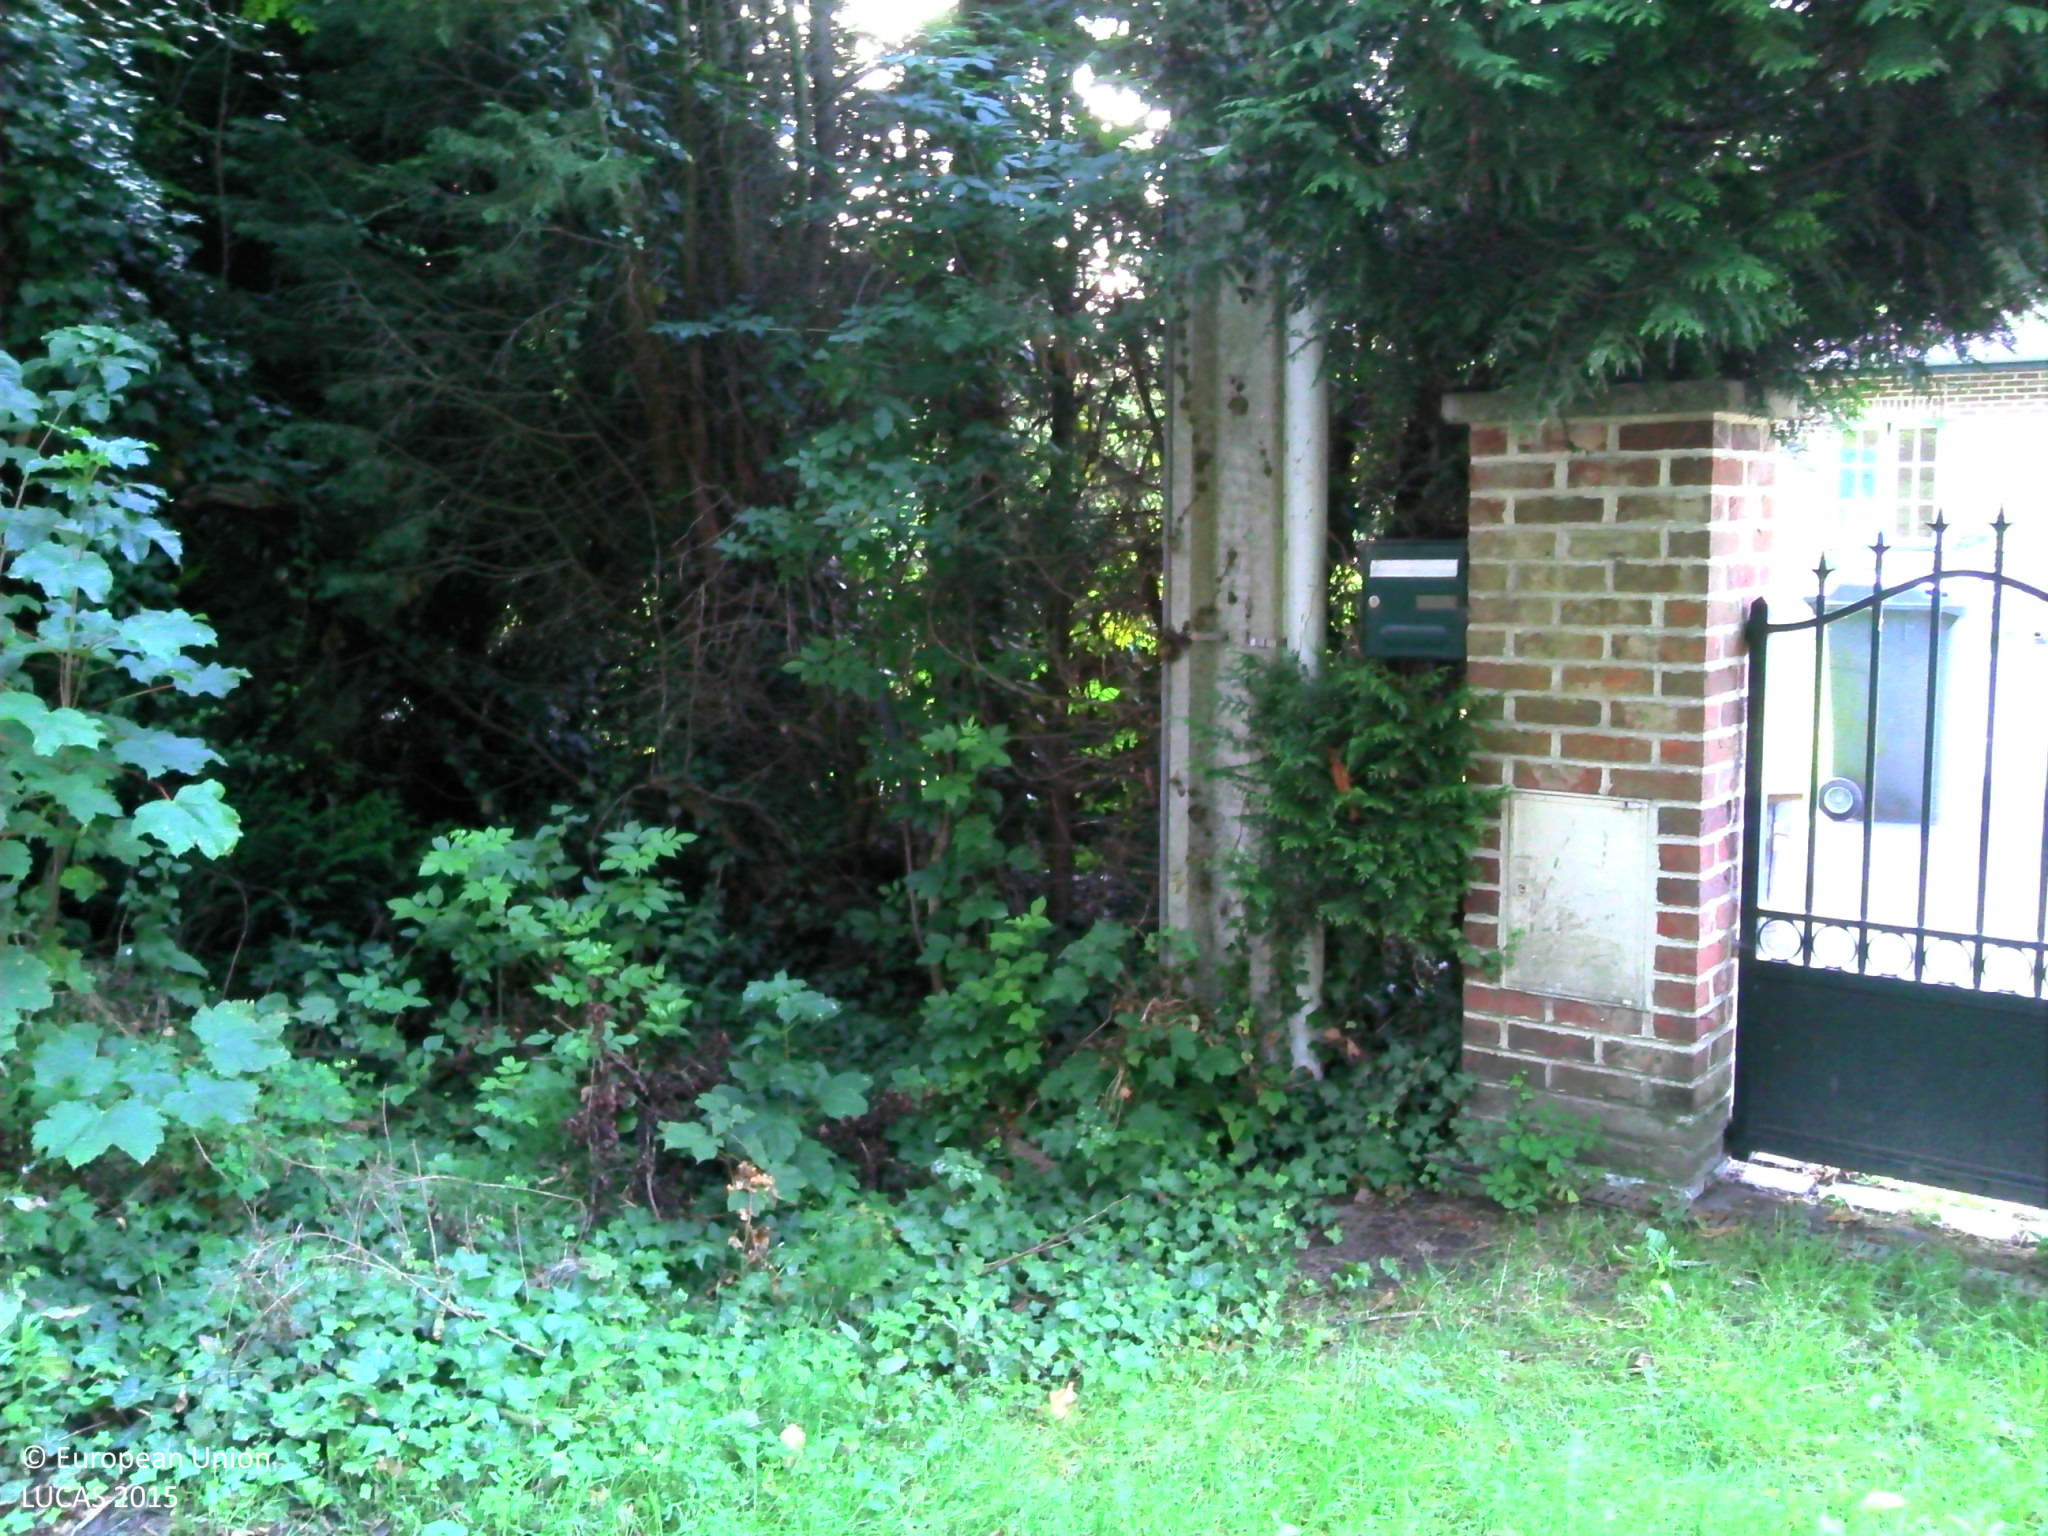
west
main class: Woodland
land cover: Broadleaved woodland
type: acidophilous oak and oak-birch forest
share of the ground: > 75 %
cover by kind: broadleaved forest trees 85 %, herbaceous plants 10 %, lichens and mosses 5 %
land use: Residential
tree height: > 5 m
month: July
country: FR
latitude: 50.7470
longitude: 3.0313
